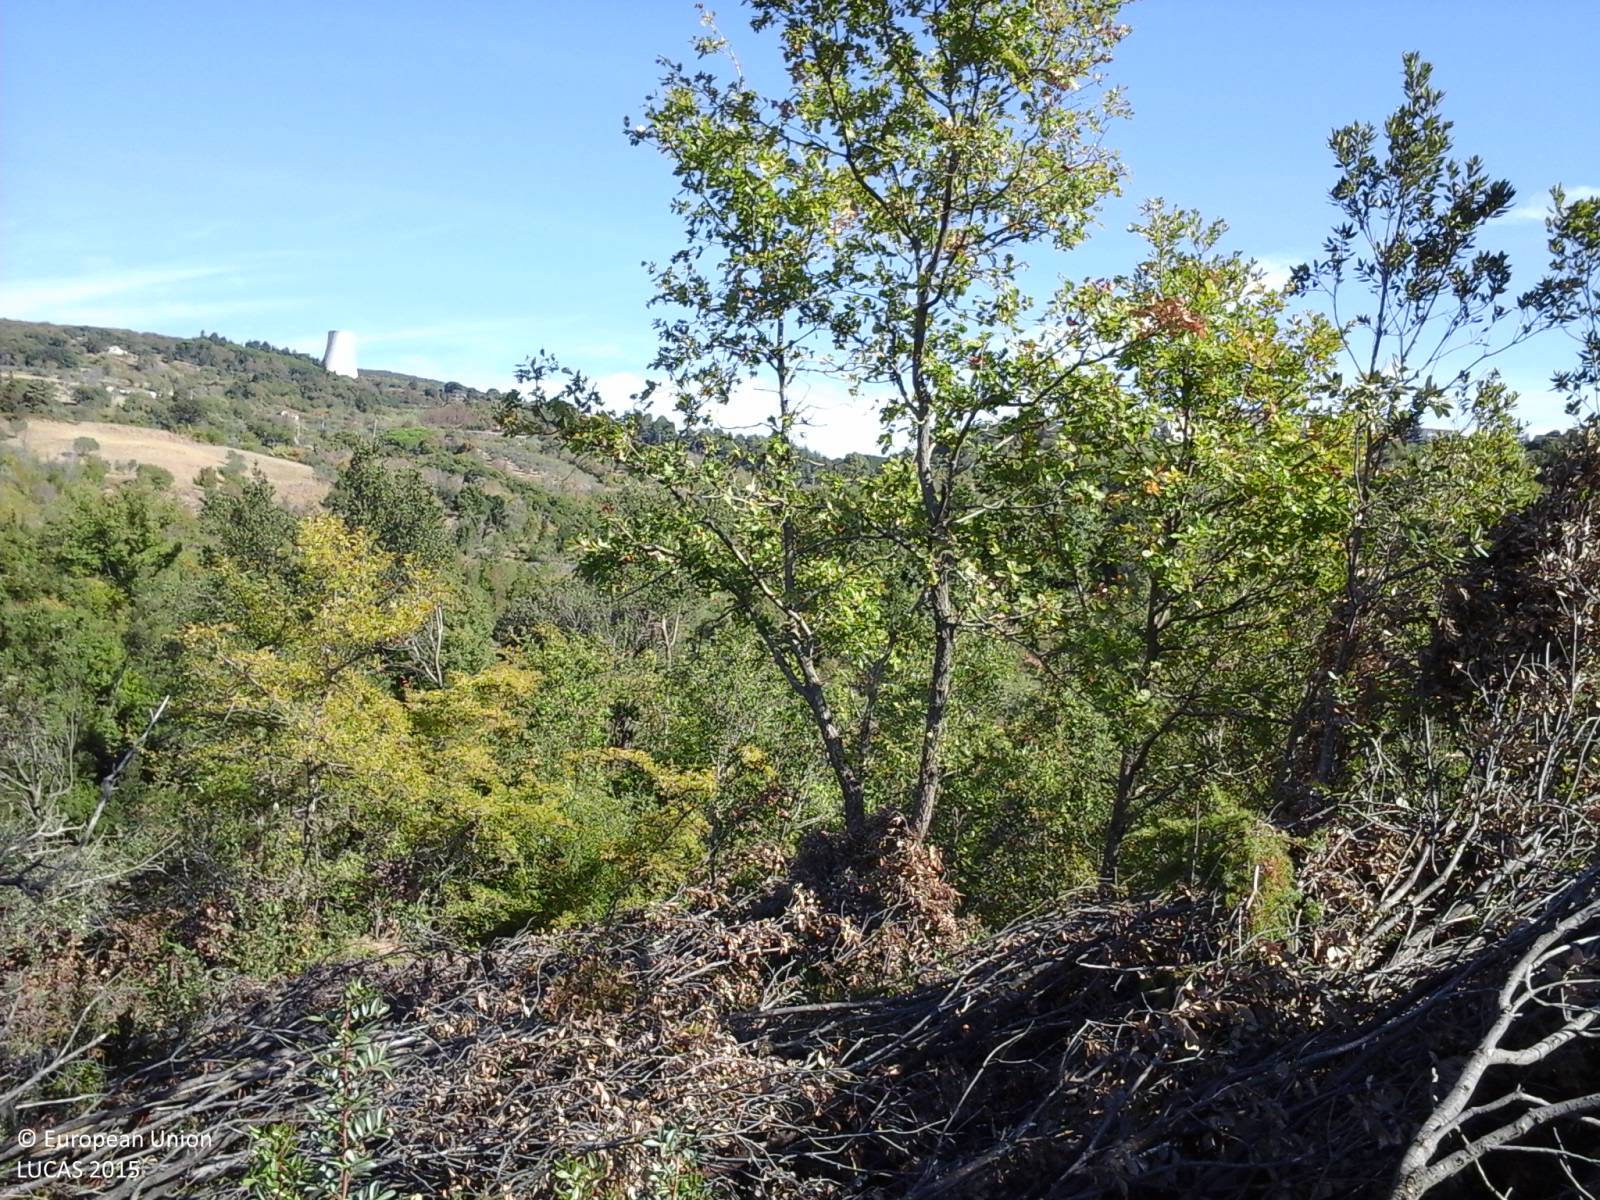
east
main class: Woodland
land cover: Broadleaved woodland
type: thermophilous deciduous forest
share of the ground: > 75 %
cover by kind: broadleaved forest trees 80 %, shrubs 20 %
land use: Forestry
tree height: > 5 m
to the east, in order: Broadleaved woodland
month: September
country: IT
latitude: 43.1380
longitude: 10.8457
